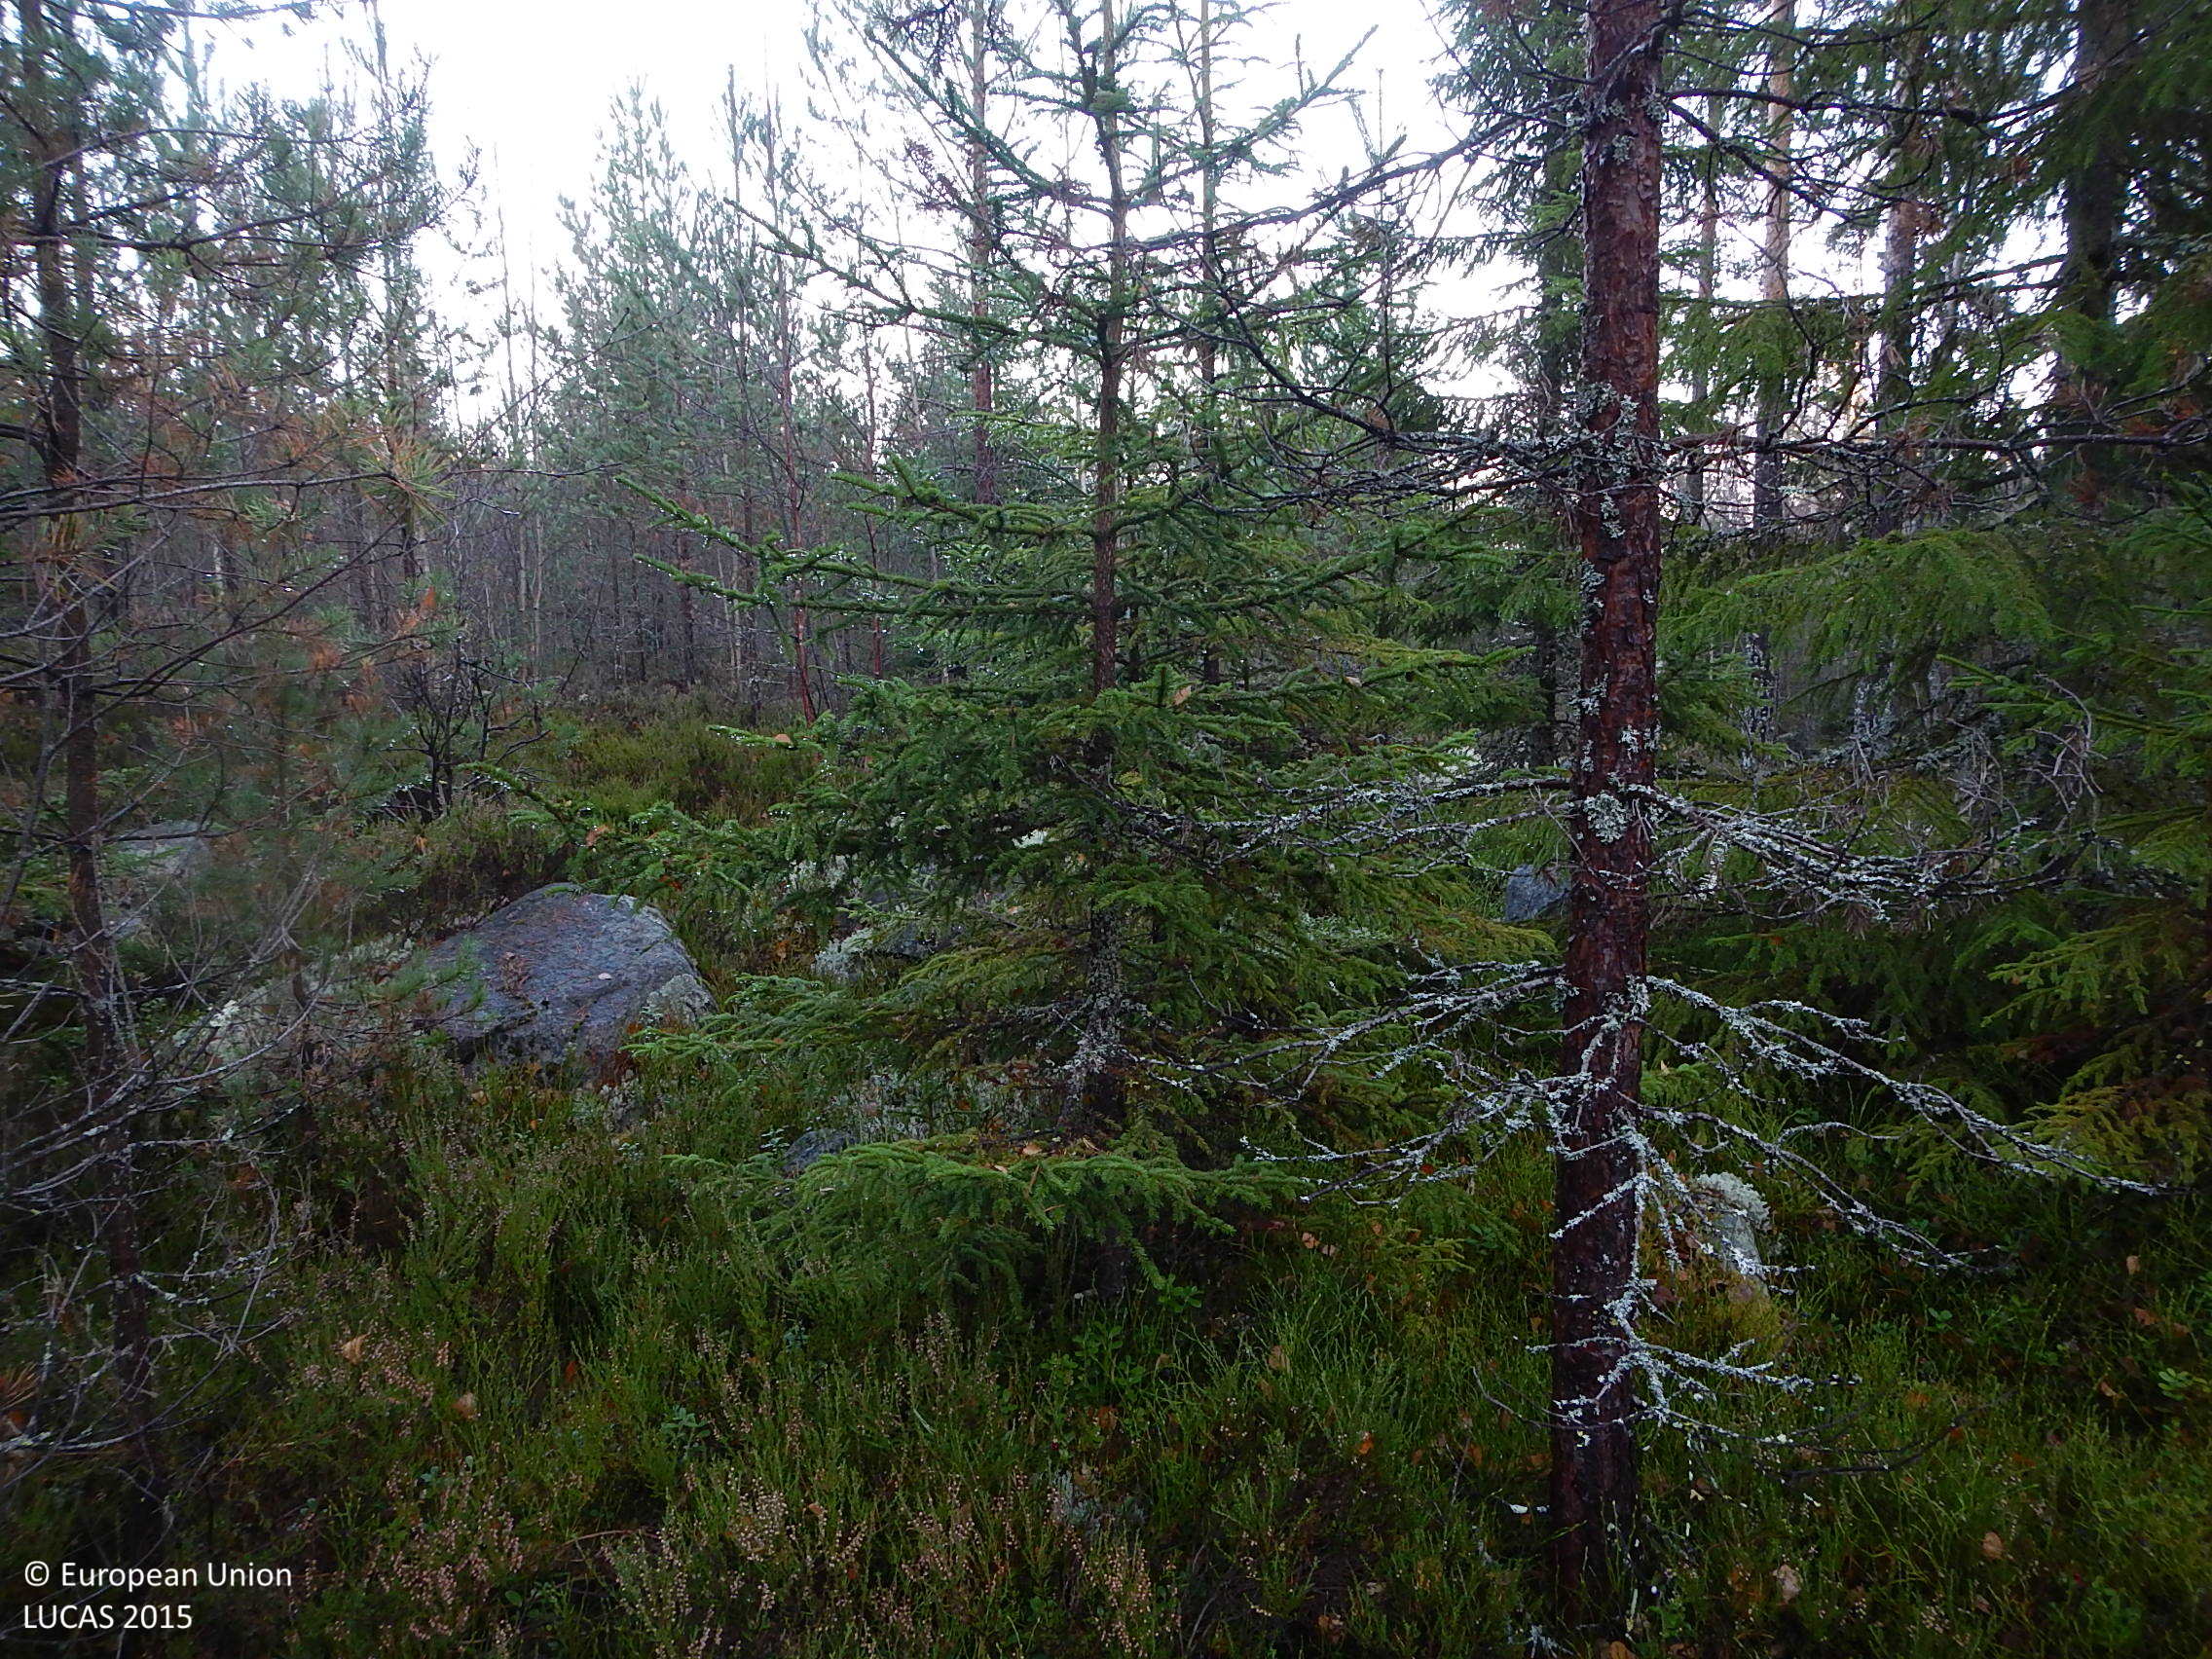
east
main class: Woodland
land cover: Other mixed woodland
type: boreal forest
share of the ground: 50 - 75 %
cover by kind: coniferous forest trees 40 %, shrubs 25 %, broadleaved forest trees 20 %, consolidated bare surface 10 %, lichens and mosses 5 %
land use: Forestry
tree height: > 5 m
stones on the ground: 10 - 25 %
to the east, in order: Other mixed woodland; Pine dominated mixed woodland; Other mixed woodland; Ditches and canals; Other mixed woodland
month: November
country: SE
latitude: 61.2005
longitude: 17.0015
